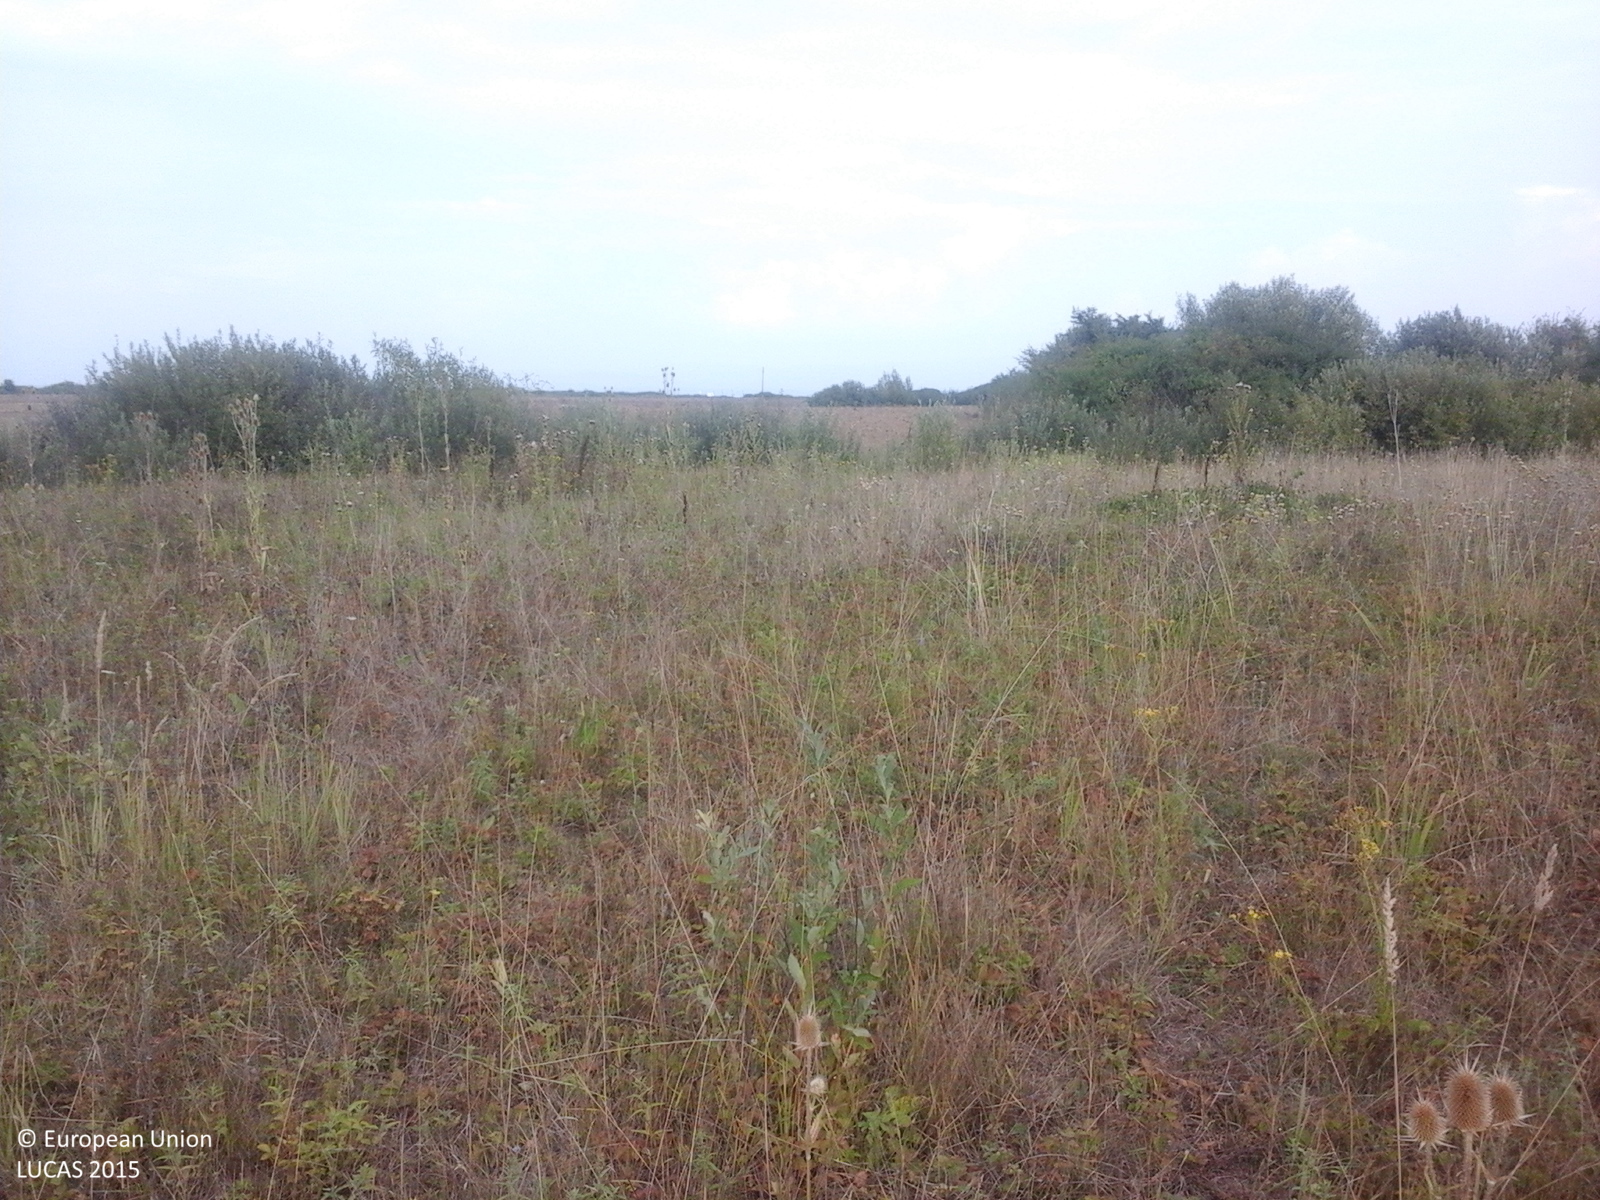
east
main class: Grassland
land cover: Grassland with sparse tree/shrub cover
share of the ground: > 75 %
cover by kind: herbaceous plants 85 %, shrubs 10 %, broadleaved forest trees 5 %
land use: Fallow land
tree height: < 5 m
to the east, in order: Grassland with sparse tree/shrub cover; Other bare soil; Shrubland with sparse tree cover; Other bare soil
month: August
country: RO
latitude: 46.5365
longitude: 21.7634
